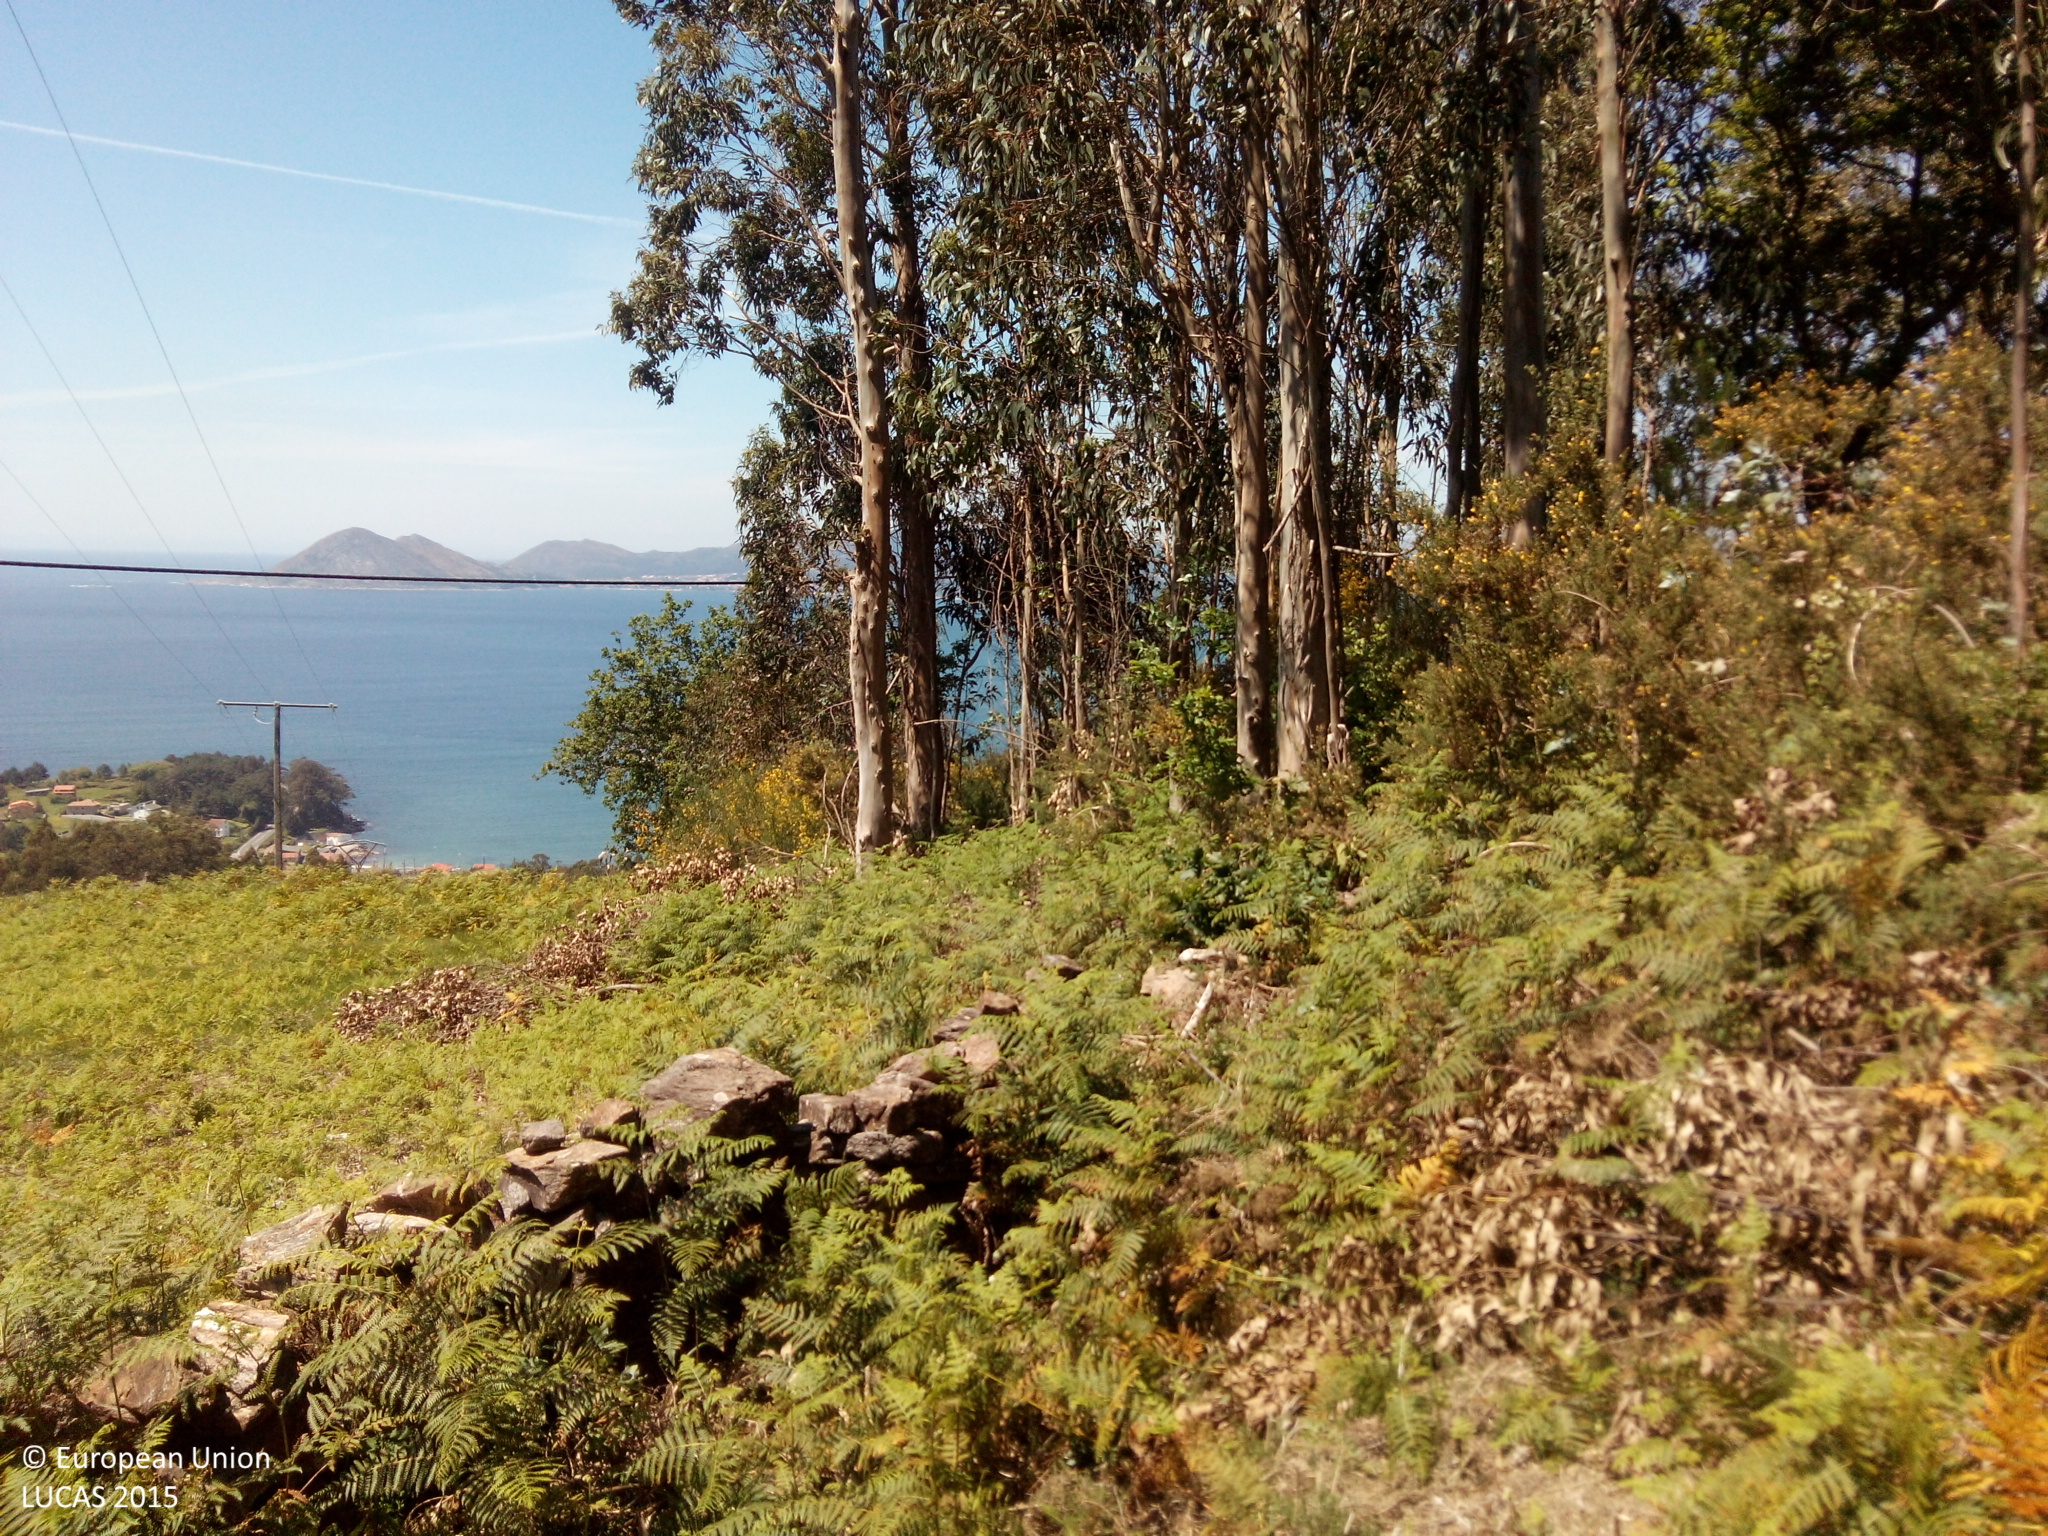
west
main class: Shrubland
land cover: Shrubland with sparse tree cover
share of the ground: > 75 %
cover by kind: shrubs 95 %, coniferous forest trees 5 %
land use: Forestry
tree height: > 5 m
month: May
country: ES
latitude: 42.7038
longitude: -9.0033
